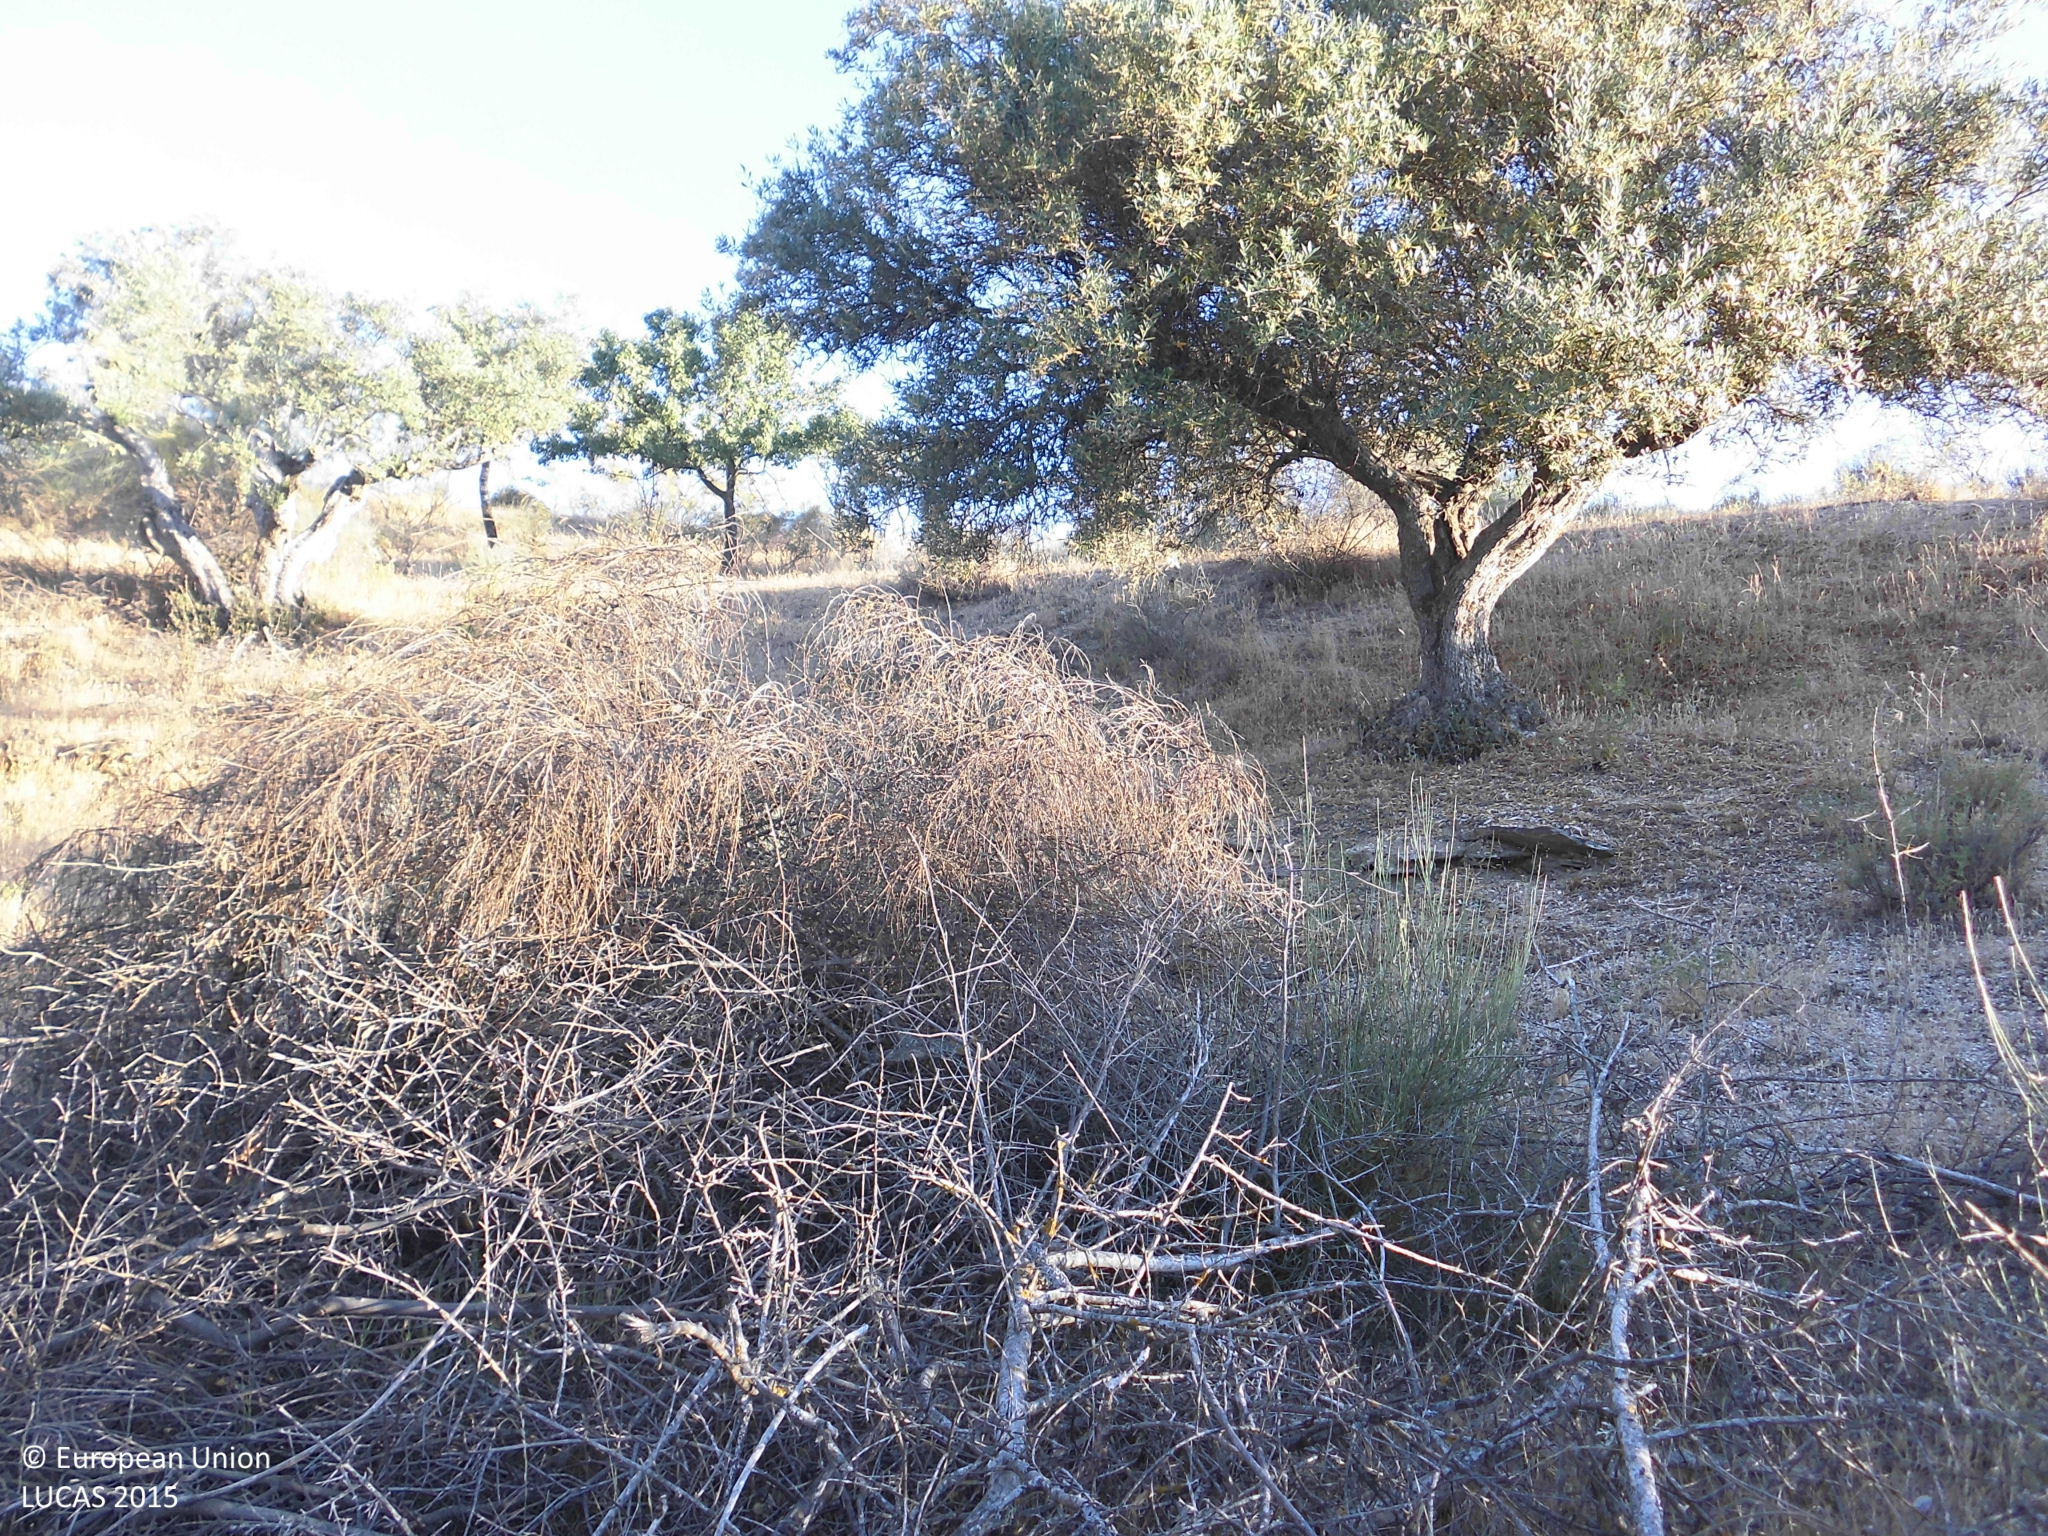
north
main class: Cropland
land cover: Olive groves
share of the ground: 10 - 25 %
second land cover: Spontaneously vegetated surfaces
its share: 50 - 75 %
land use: Agriculture (excluding fallow land and kitchen gardens)
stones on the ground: 10 - 25 %
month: May
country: ES
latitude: 39.7875
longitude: -6.6728
